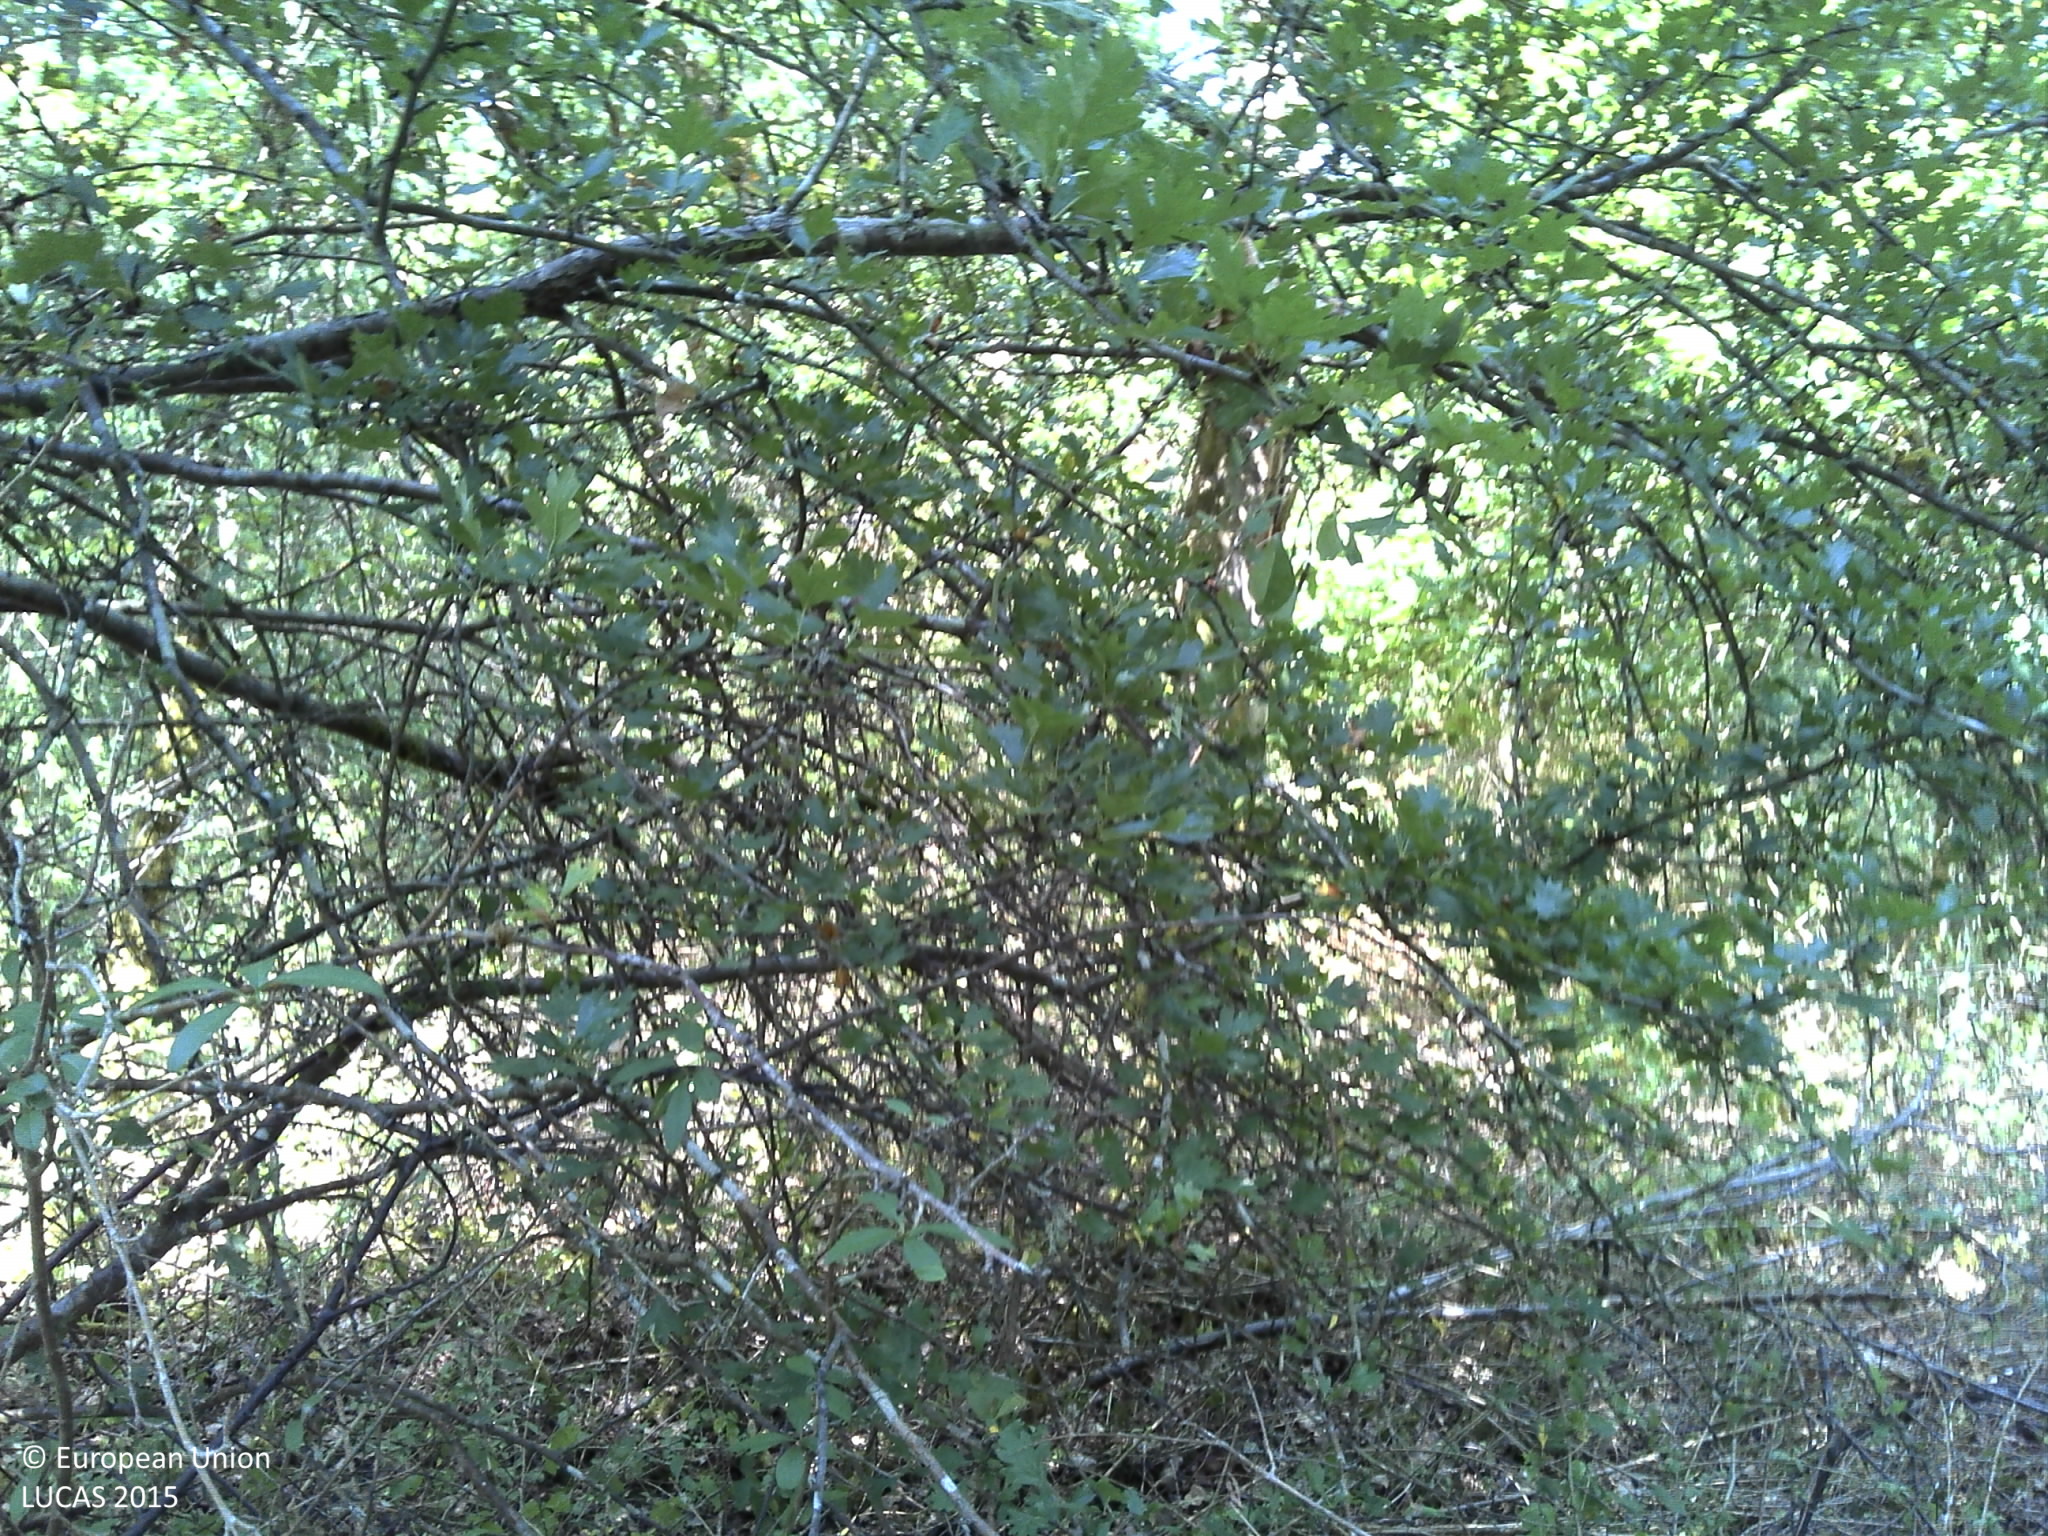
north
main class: Woodland
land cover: Broadleaved woodland
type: acidophilous oak and oak-birch forest
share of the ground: 50 - 75 %
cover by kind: broadleaved forest trees 90 %
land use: Forestry
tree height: > 5 m
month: July
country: FR
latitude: 48.4153
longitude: 2.4364
